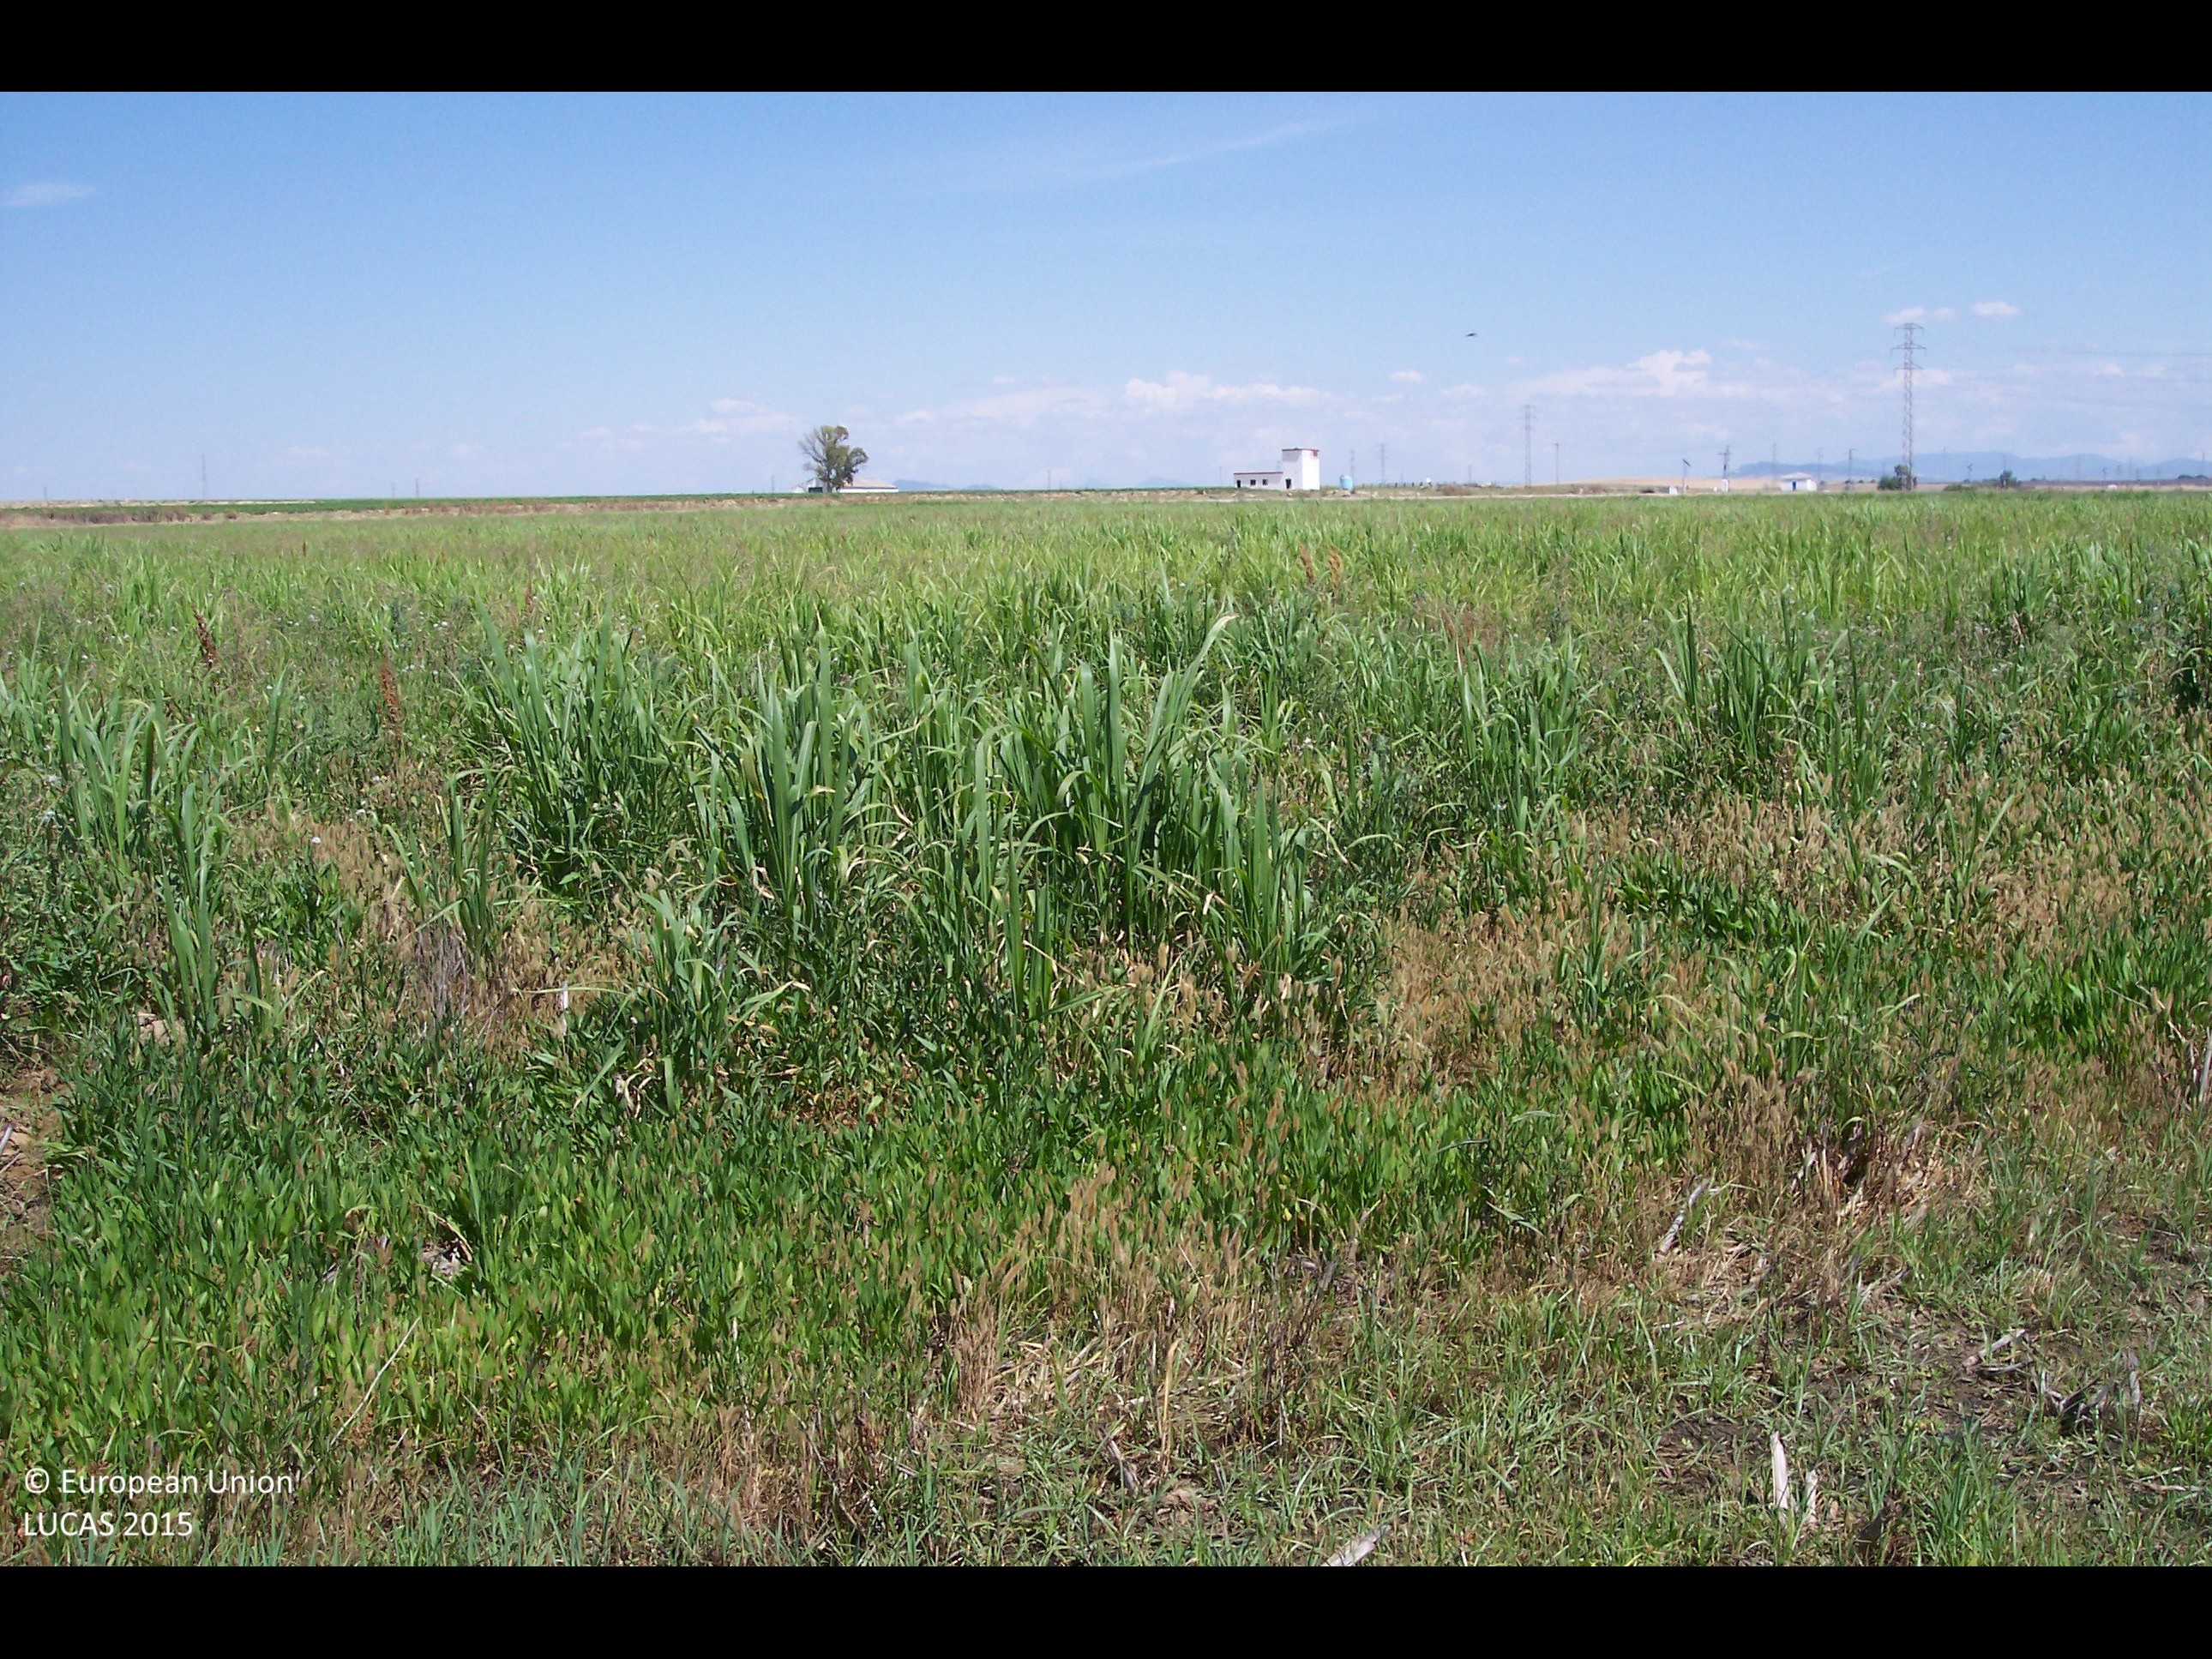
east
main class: Grassland
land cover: Spontaneously vegetated surfaces
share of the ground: > 75 %
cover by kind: herbaceous plants 100 %
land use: Fallow land
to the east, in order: Spontaneously vegetated surfaces; Maize
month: May
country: ES
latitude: 37.1275
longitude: -5.8534
